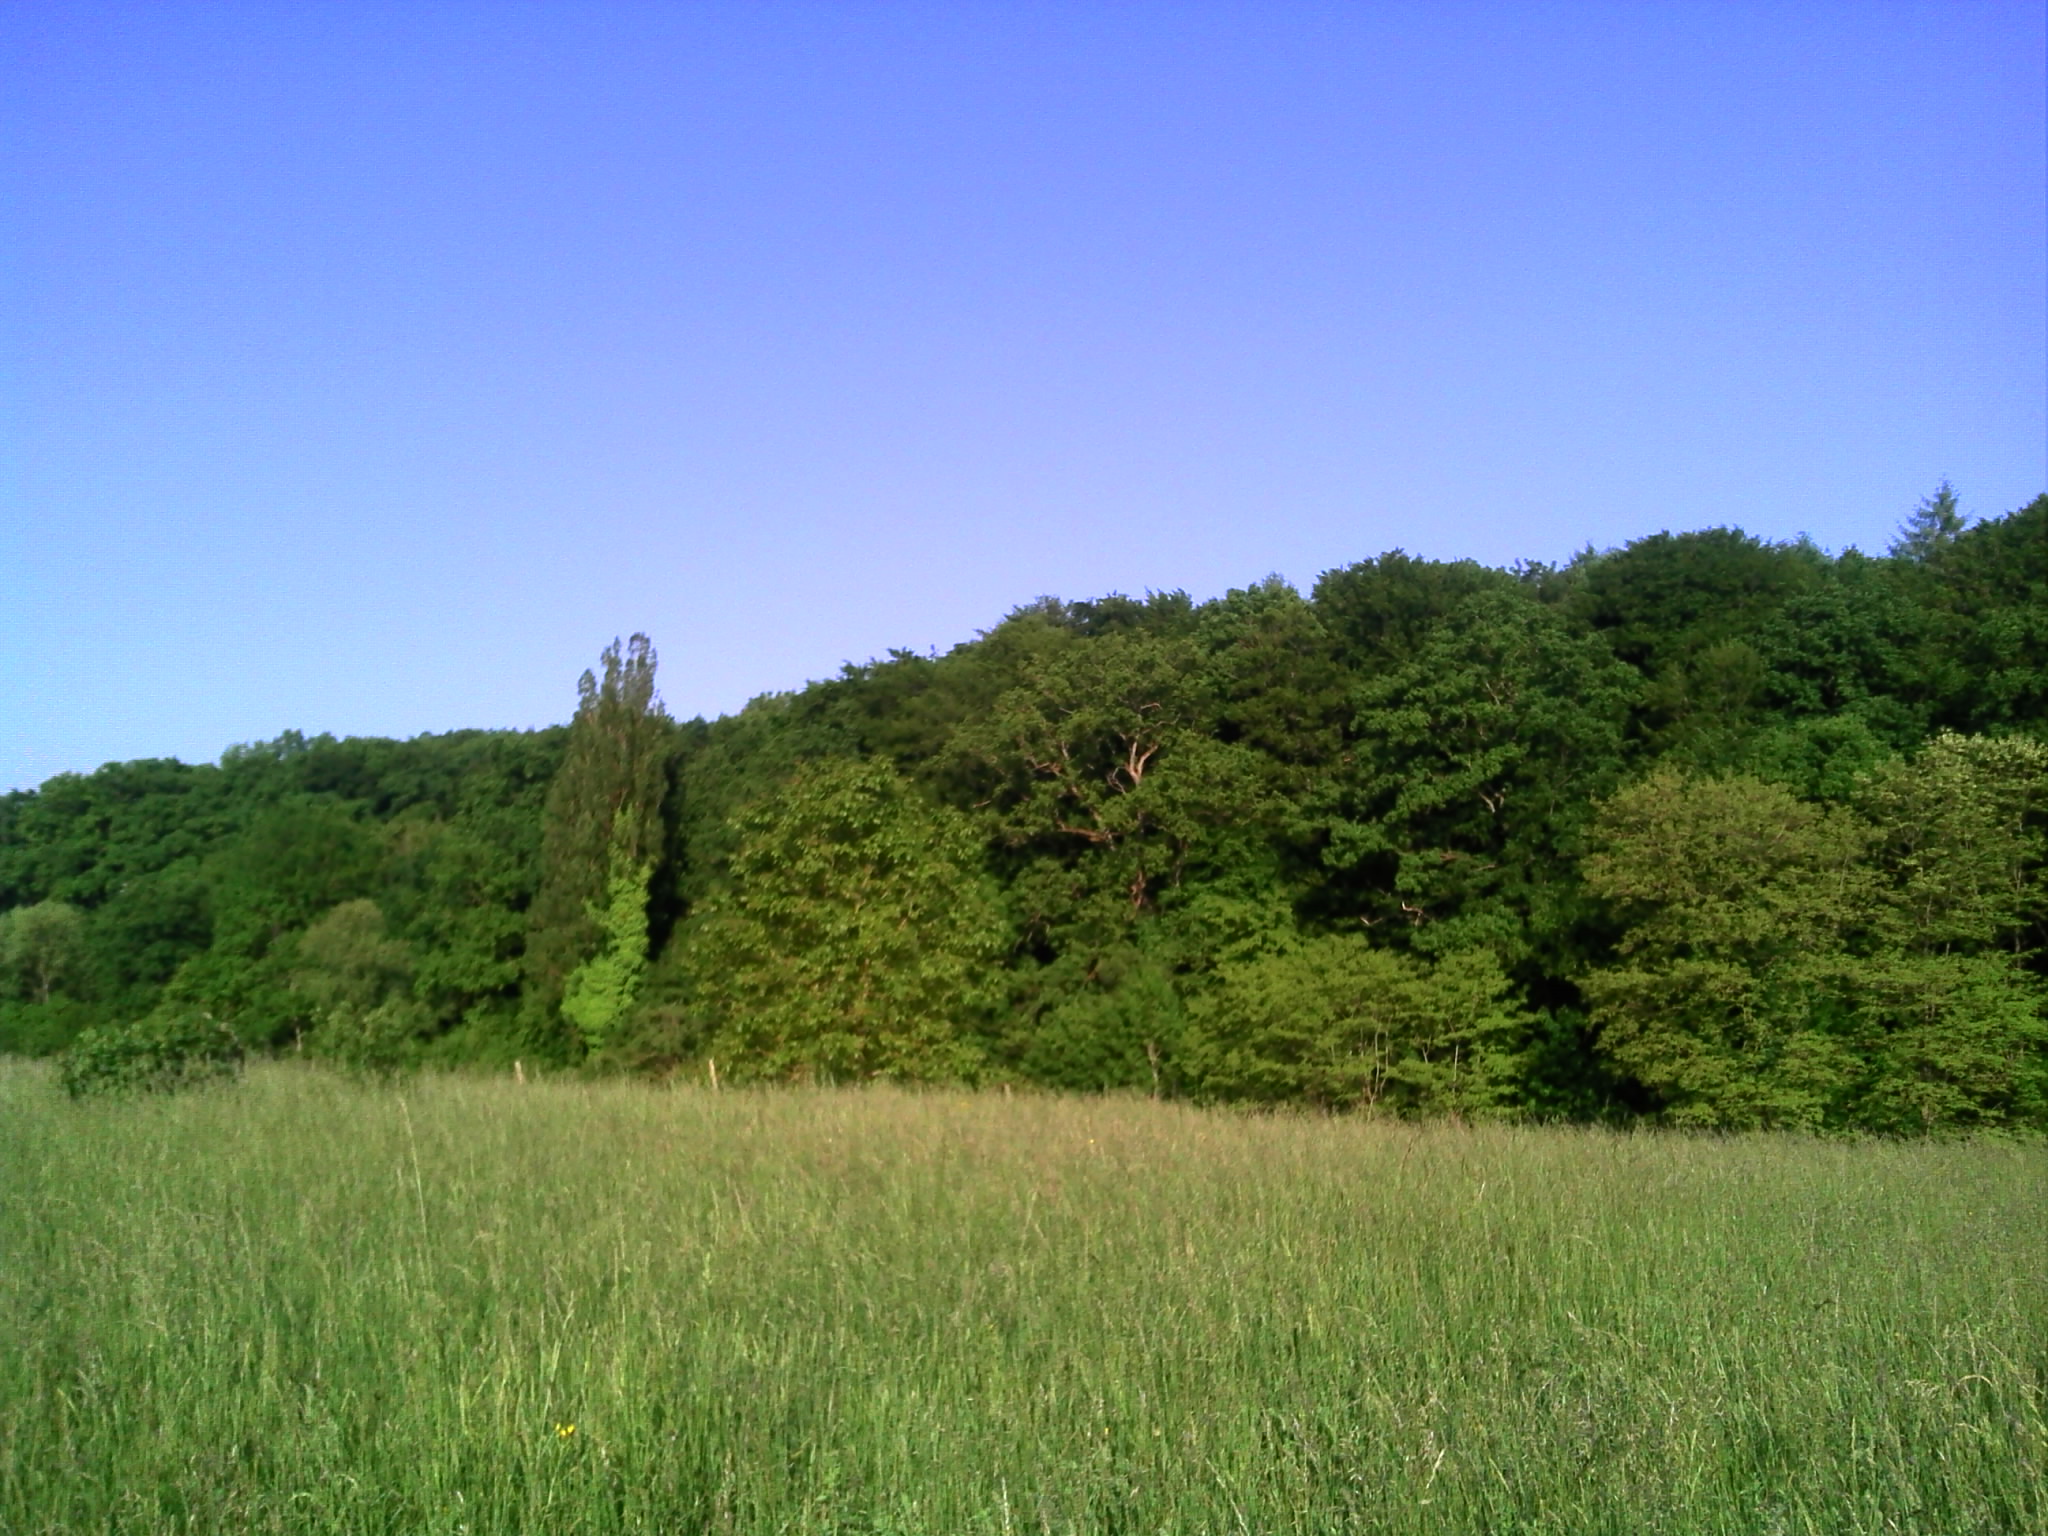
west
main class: Grassland
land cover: Grassland with sparse tree/shrub cover
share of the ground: > 75 %
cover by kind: herbaceous plants 95 %, broadleaved forest trees 5 %
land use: Agriculture (excluding fallow land and kitchen gardens)
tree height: < 5 m
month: May
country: LU
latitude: 49.5502
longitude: 6.3645
